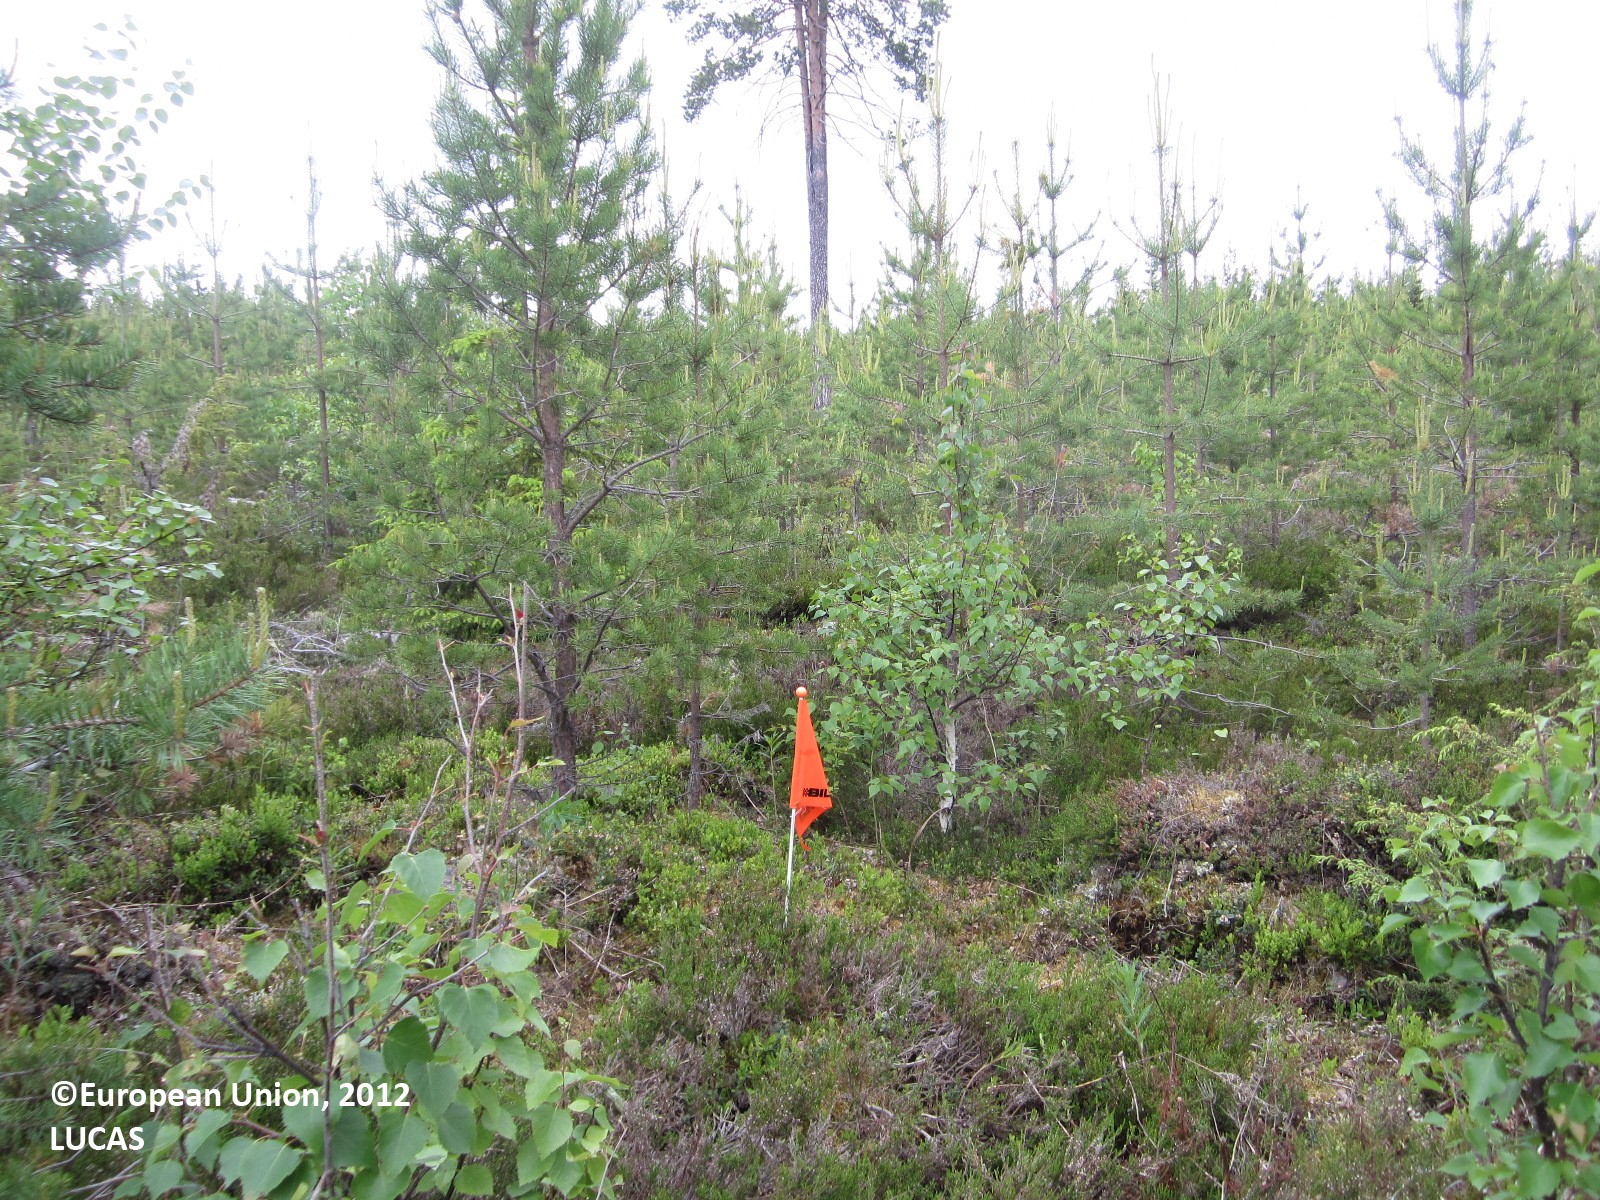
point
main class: Woodland
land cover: Pine dominated mixed woodland
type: boreal forest
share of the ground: 50 - 75 %
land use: Forestry
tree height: < 5 m
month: June
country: FI
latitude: 64.3570
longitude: 29.5830
